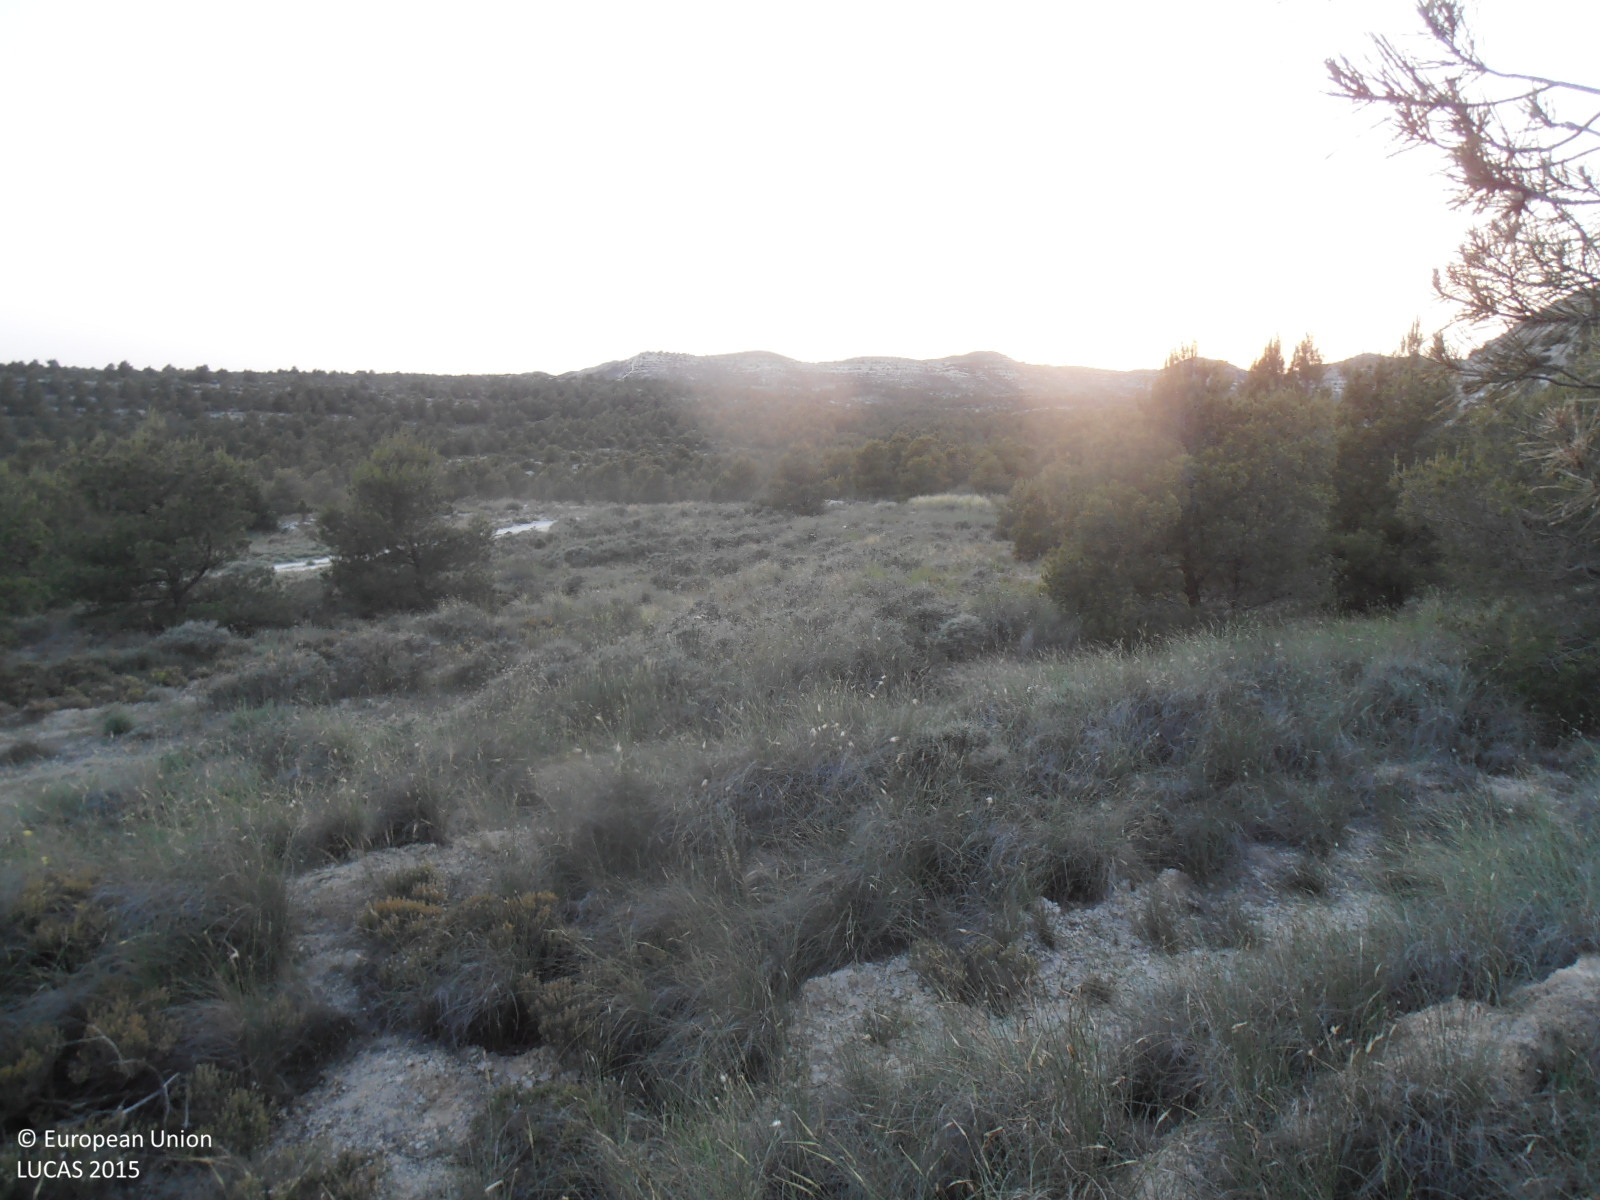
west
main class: Woodland
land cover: Pine dominated coniferous woodland
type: coniferous forest of the mediterranean region
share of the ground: 25 - 50 %
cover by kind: coniferous forest trees 45 %, shrubs 30 %, consolidated bare surface 25 %
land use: Forestry
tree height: < 5 m
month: May
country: ES
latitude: 41.5772
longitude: -1.0204
